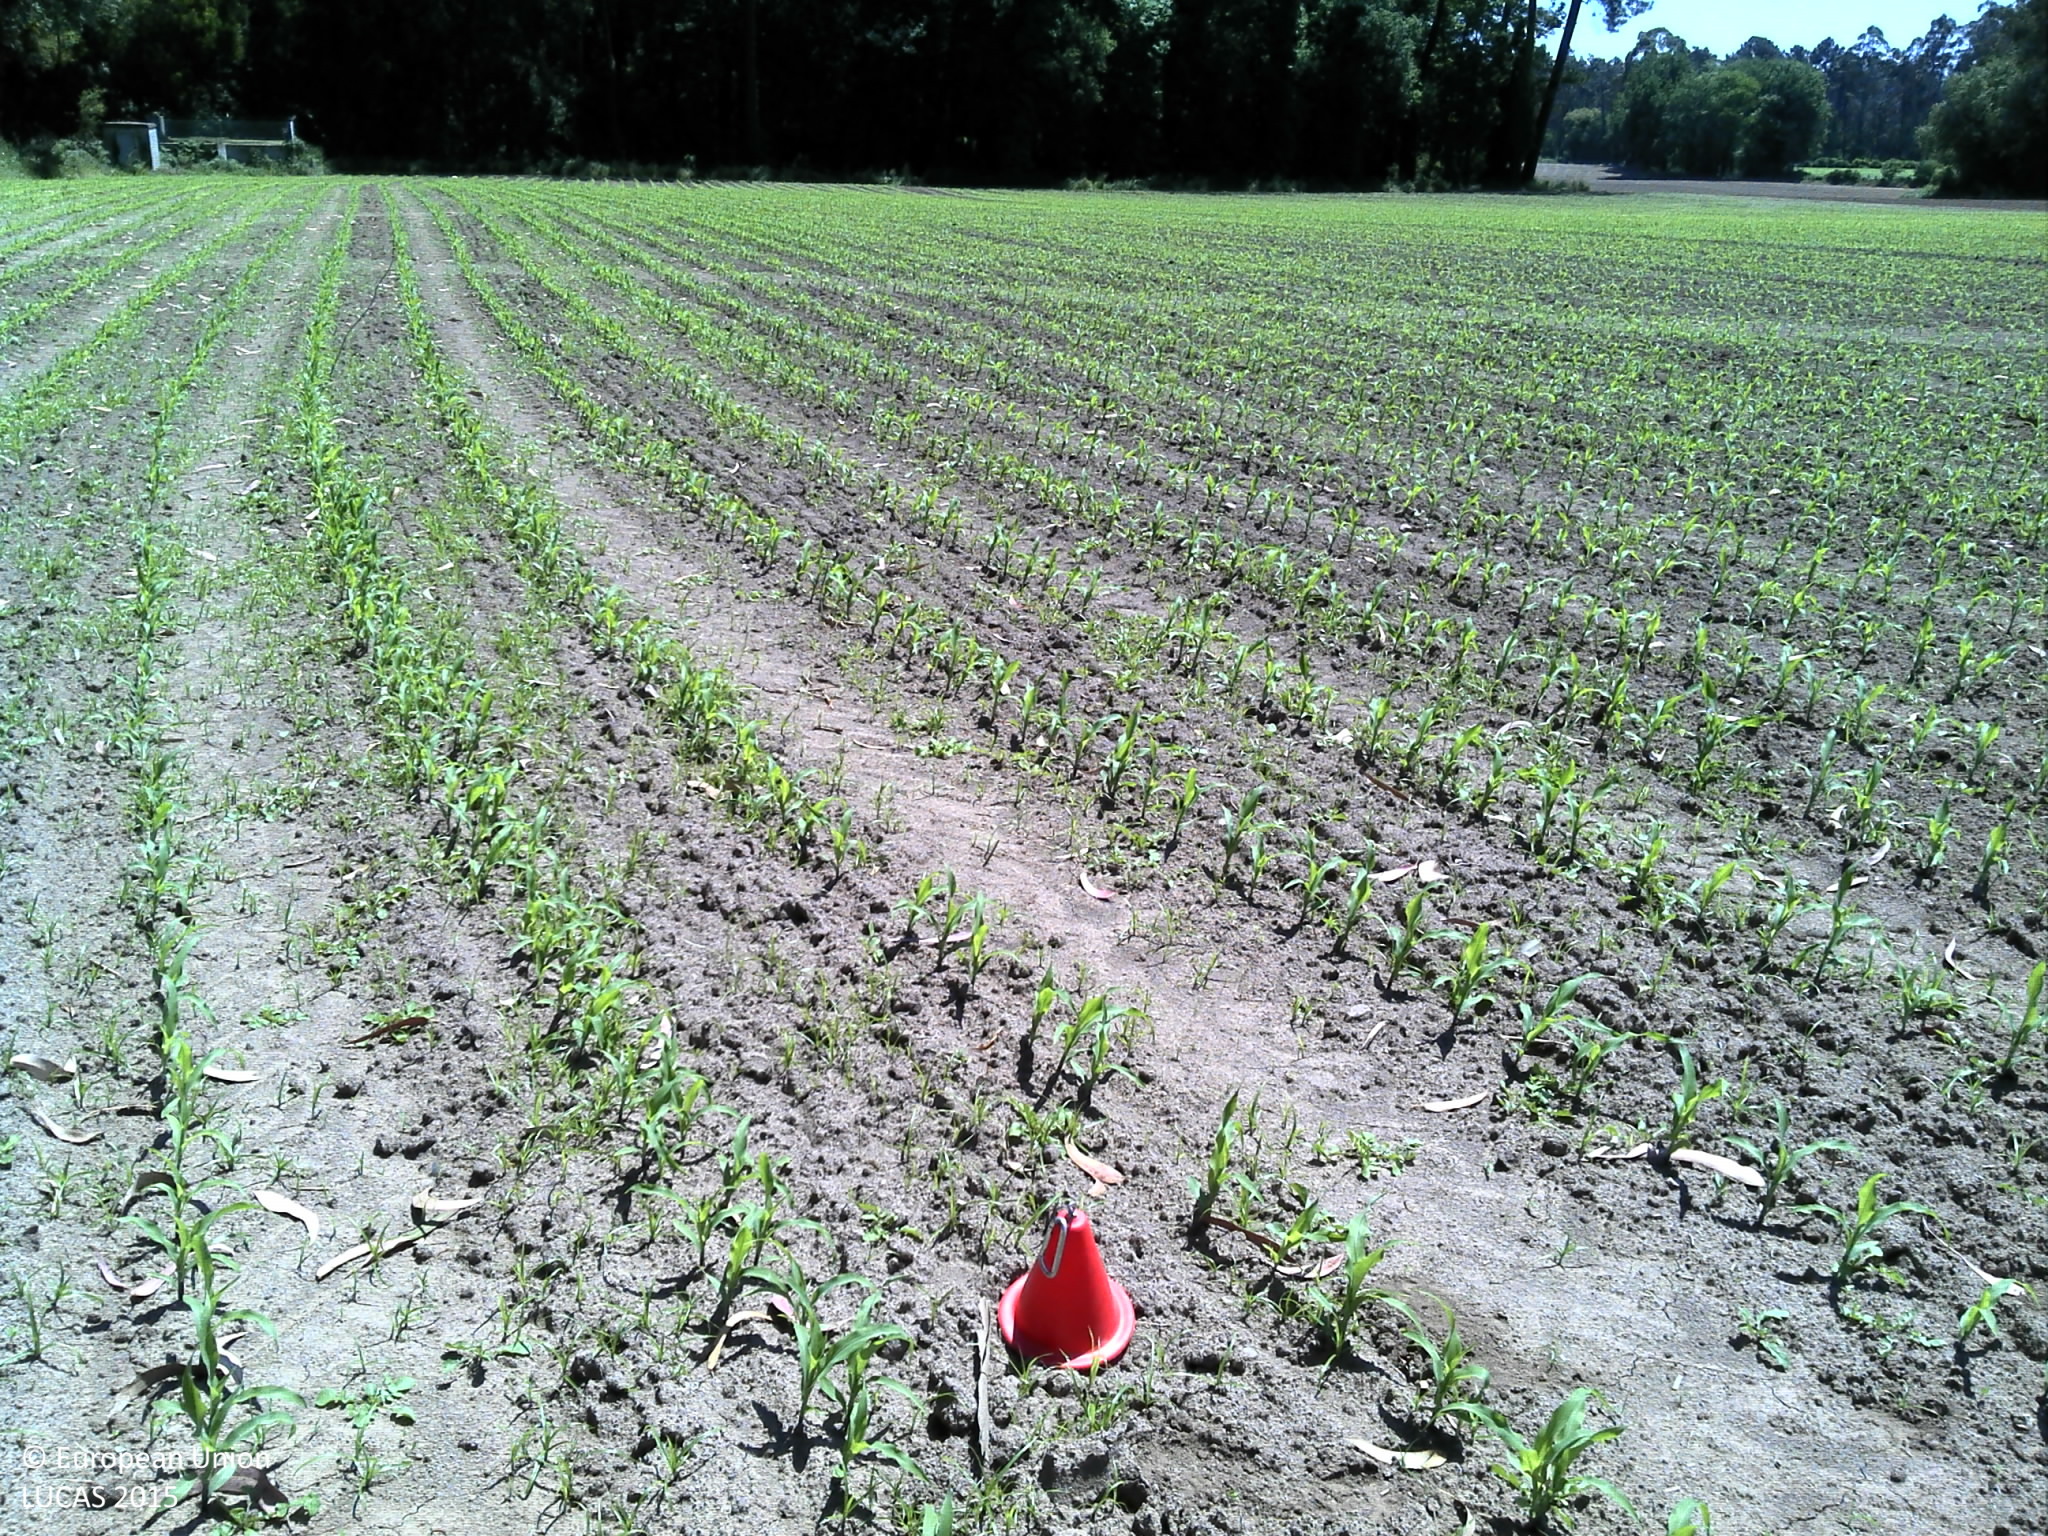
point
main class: Cropland
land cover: Maize
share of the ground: 10 - 25 %
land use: Agriculture (excluding fallow land and kitchen gardens)
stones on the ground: < 10 %
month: May
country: PT
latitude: 41.3610
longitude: -8.6748
